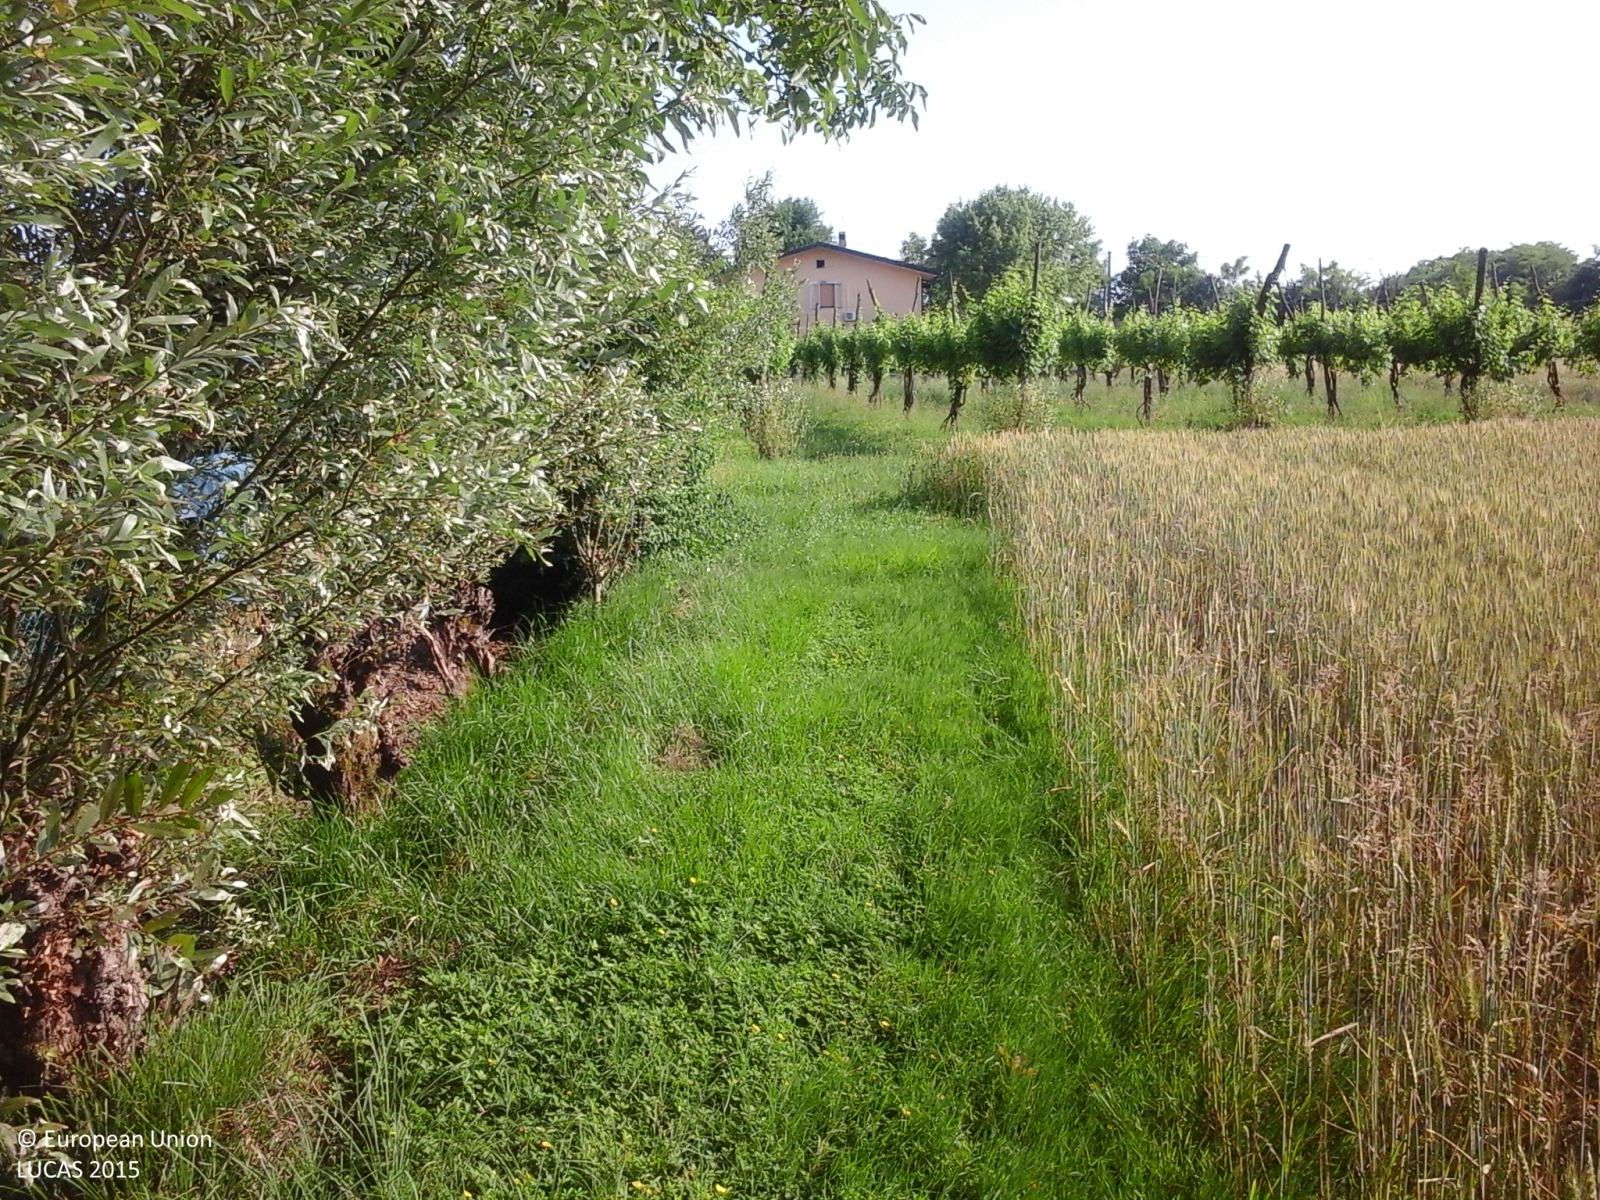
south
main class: Cropland
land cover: Common wheat
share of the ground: > 75 %
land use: Agriculture (excluding fallow land and kitchen gardens)
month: June
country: IT
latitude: 45.6052
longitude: 12.3172
